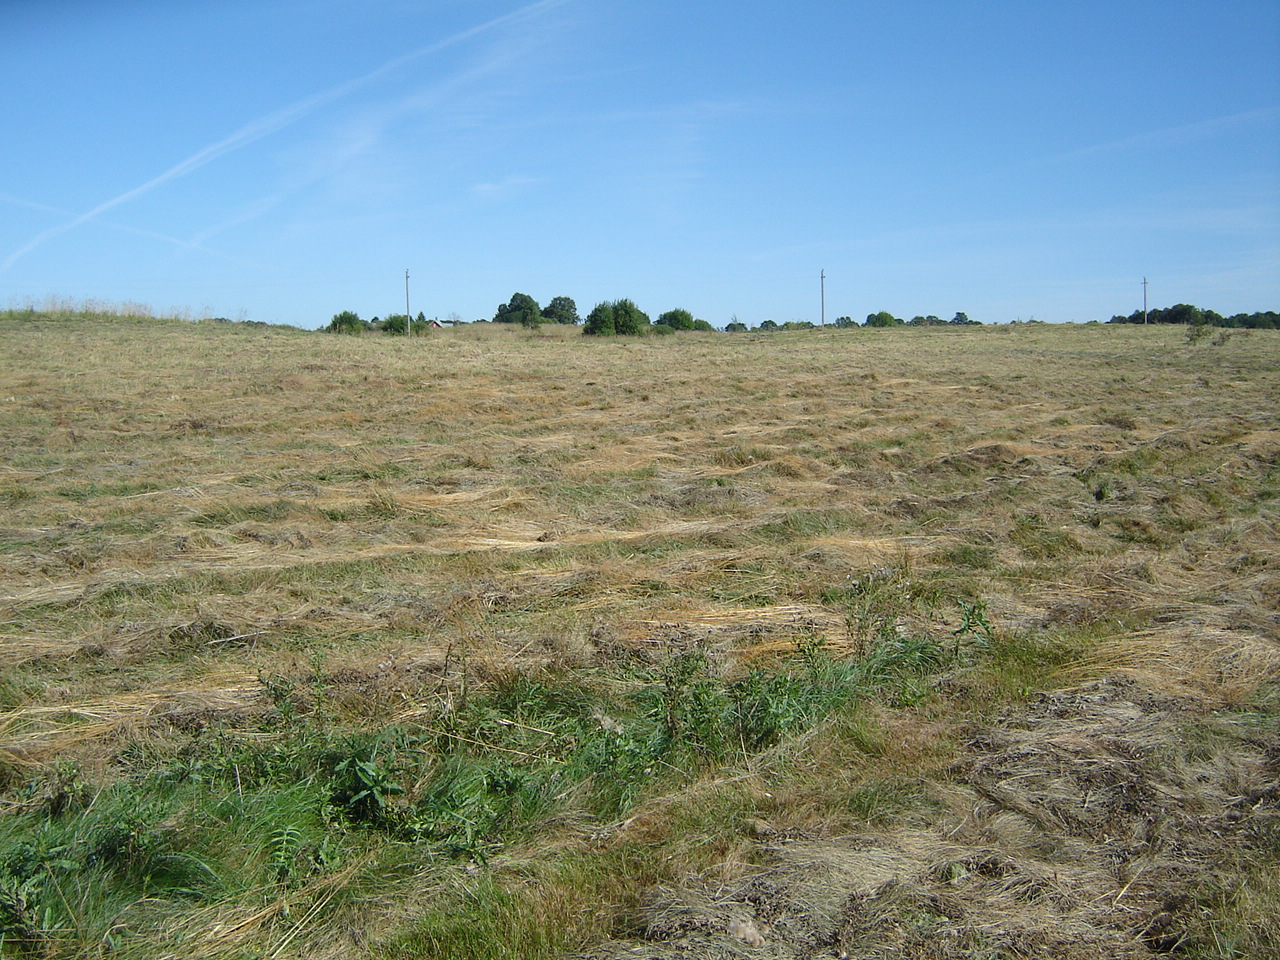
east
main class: Grassland
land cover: Grassland without tree/shrub cover
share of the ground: > 75 %
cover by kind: herbaceous plants 100 %
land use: Agriculture (excluding fallow land and kitchen gardens)
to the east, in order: Grassland without tree/shrub cover; Tracks; Grassland without tree/shrub cover; Electric lines; Grassland without tree/shrub cover; Spontaneously vegetated surfaces; Broadleaved woodland; Spontaneously vegetated surfaces
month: August
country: LT
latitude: 54.8826
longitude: 25.2556
